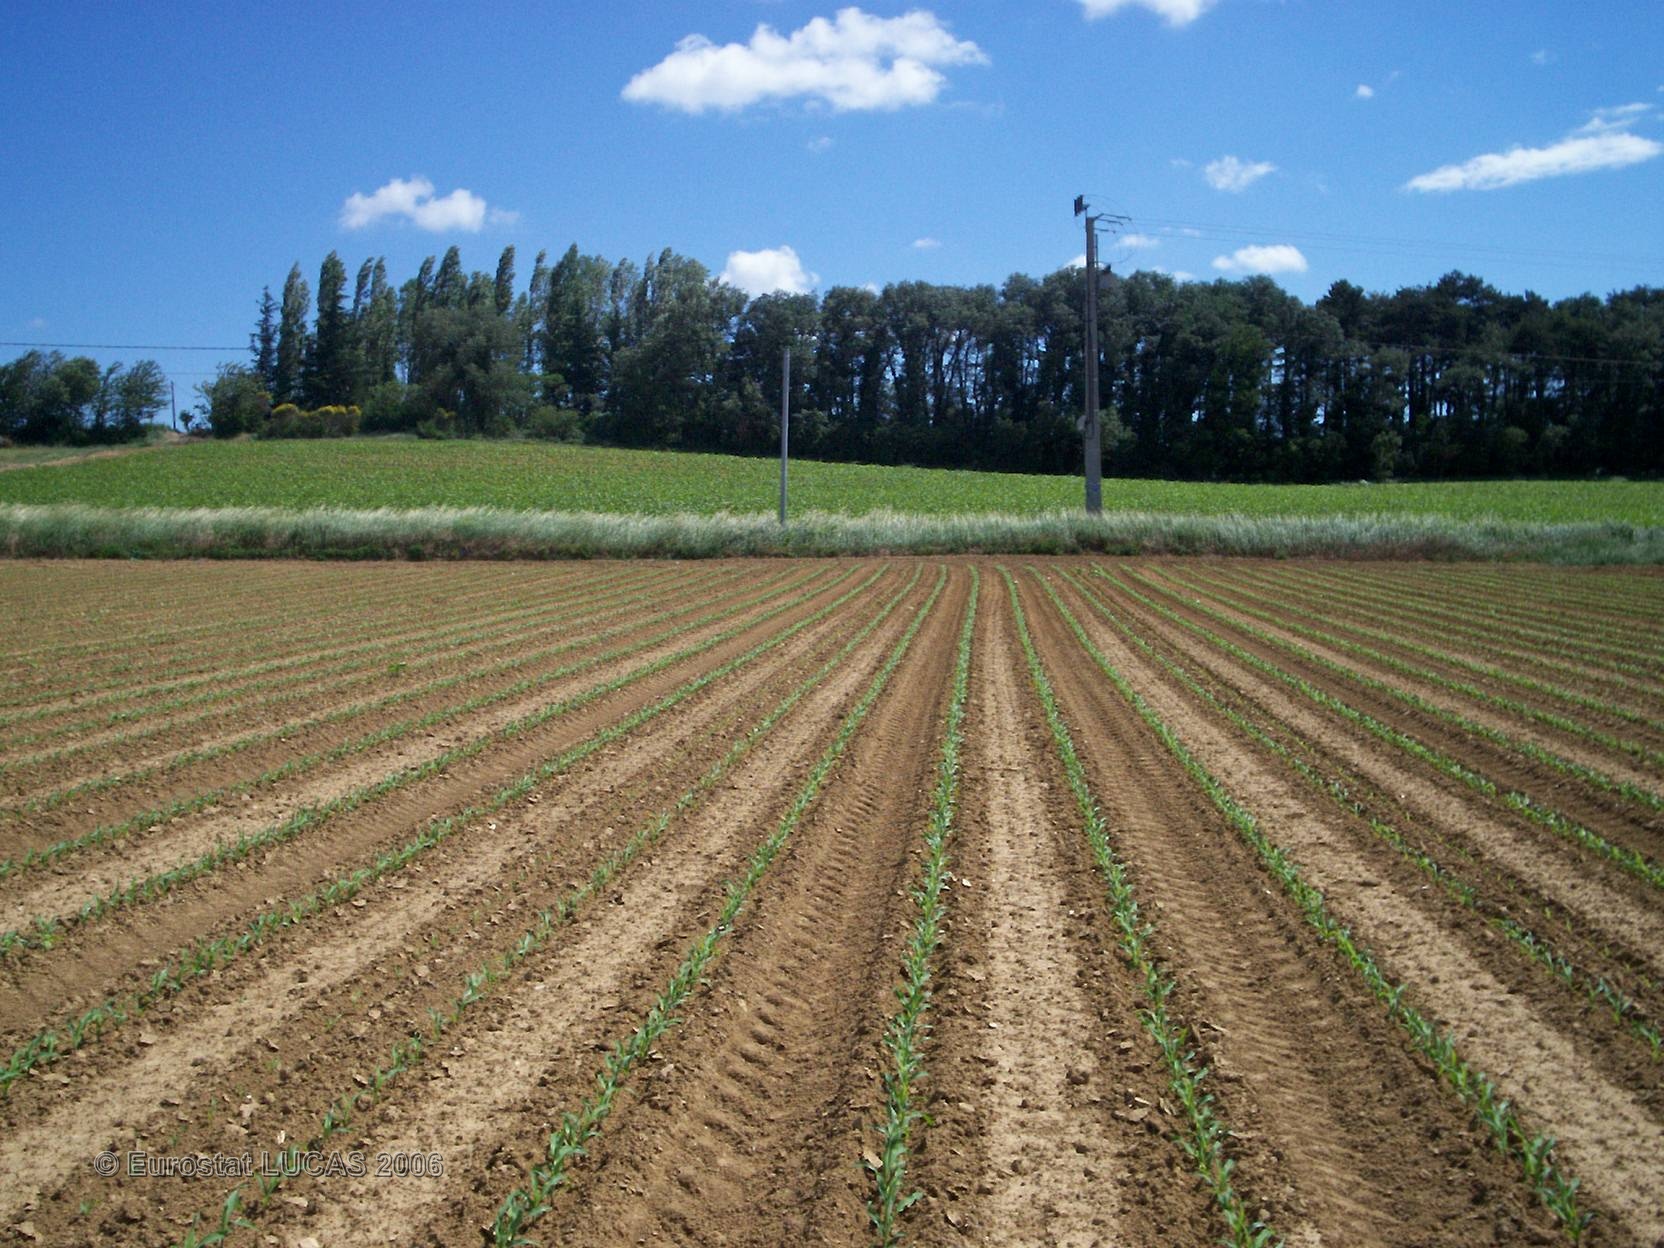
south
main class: Cropland
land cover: Maize
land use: Agriculture (excluding fallow land and kitchen gardens)
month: May
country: FR
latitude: 44.5663
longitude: 4.8569
